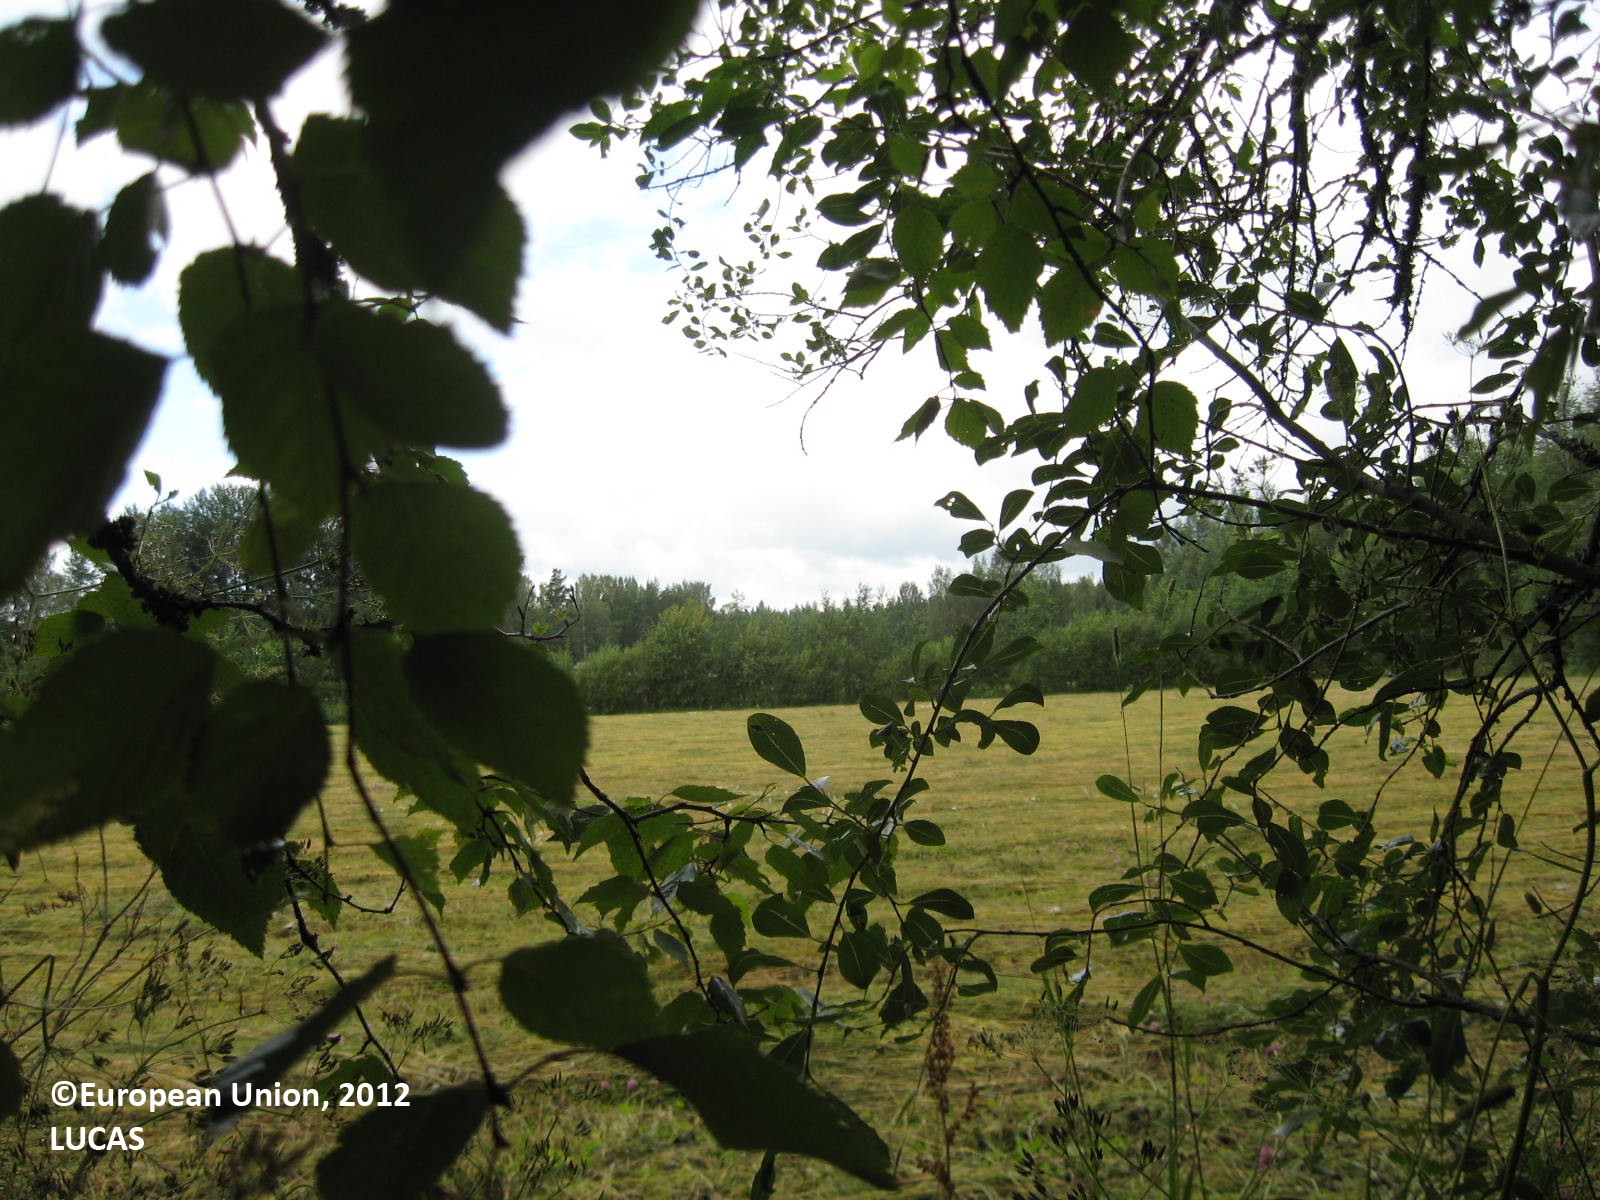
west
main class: Woodland
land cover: Broadleaved woodland
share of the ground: > 75 %
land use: Forestry
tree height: > 5 m
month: July
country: FI
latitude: 62.0870
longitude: 22.5249
